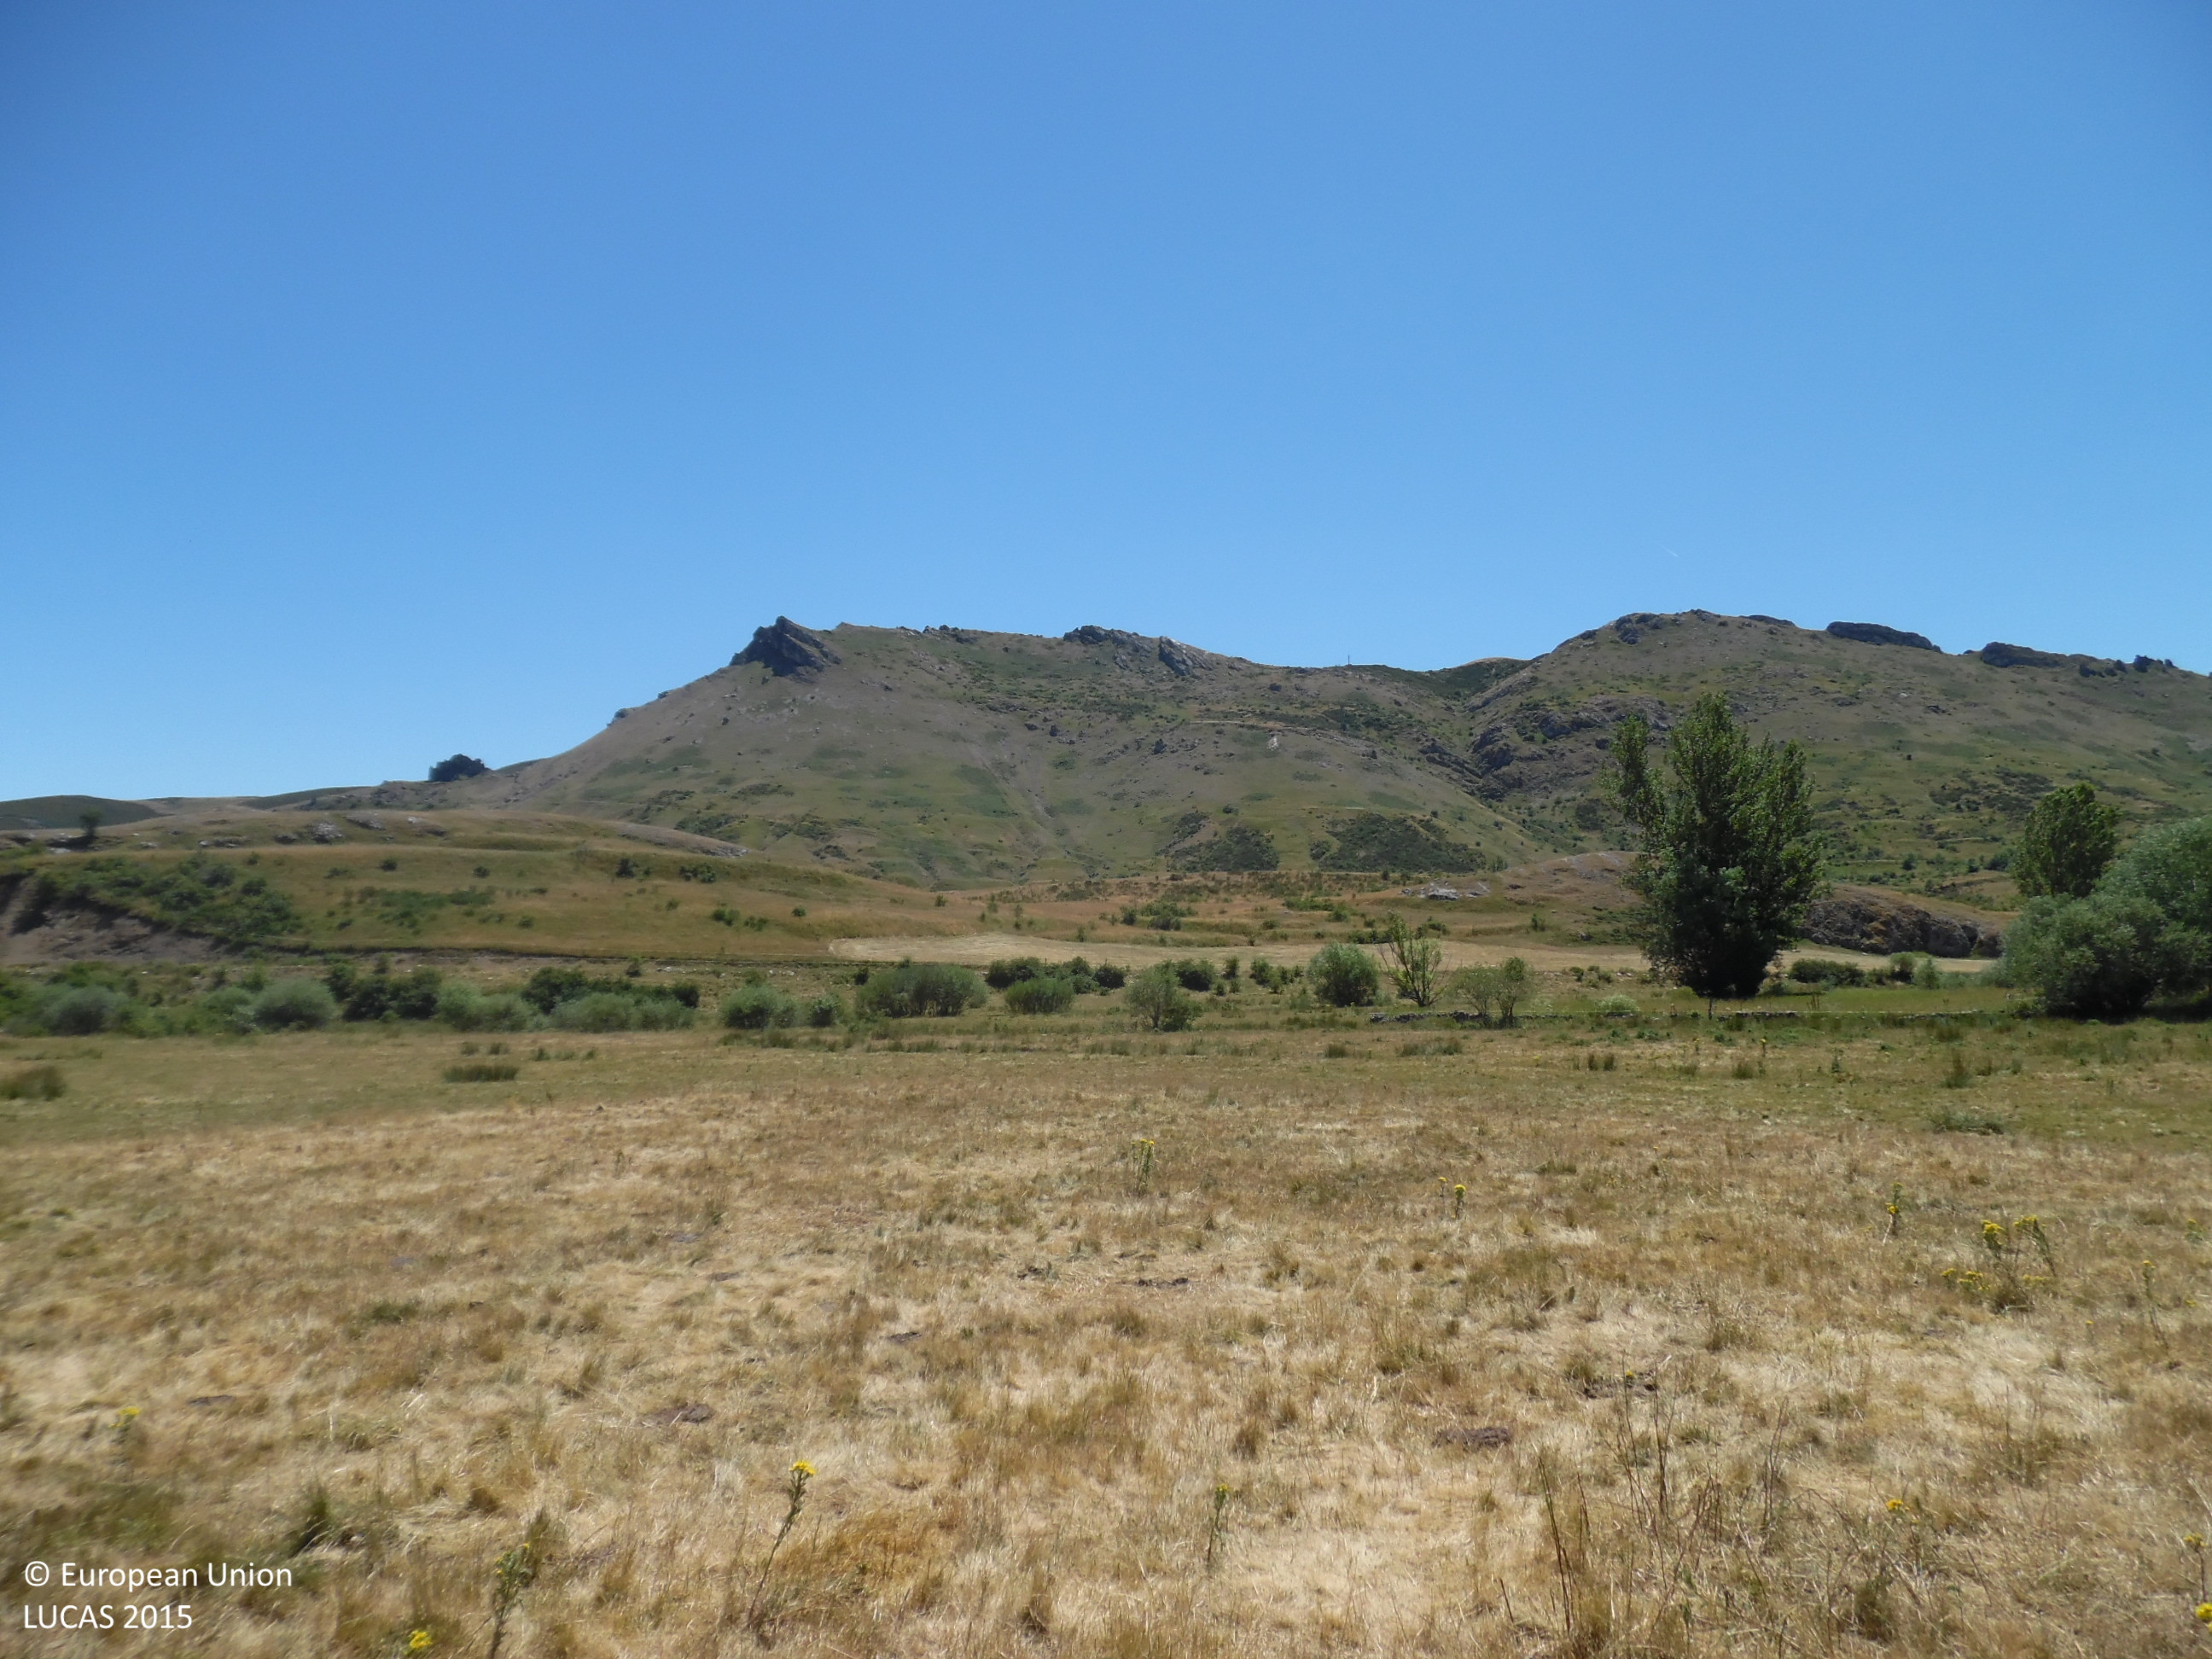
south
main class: Grassland
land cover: Grassland without tree/shrub cover
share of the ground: > 75 %
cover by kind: herbaceous plants 100 %
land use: Agriculture (excluding fallow land and kitchen gardens)
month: July
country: ES
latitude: 42.9287
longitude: -5.8017
